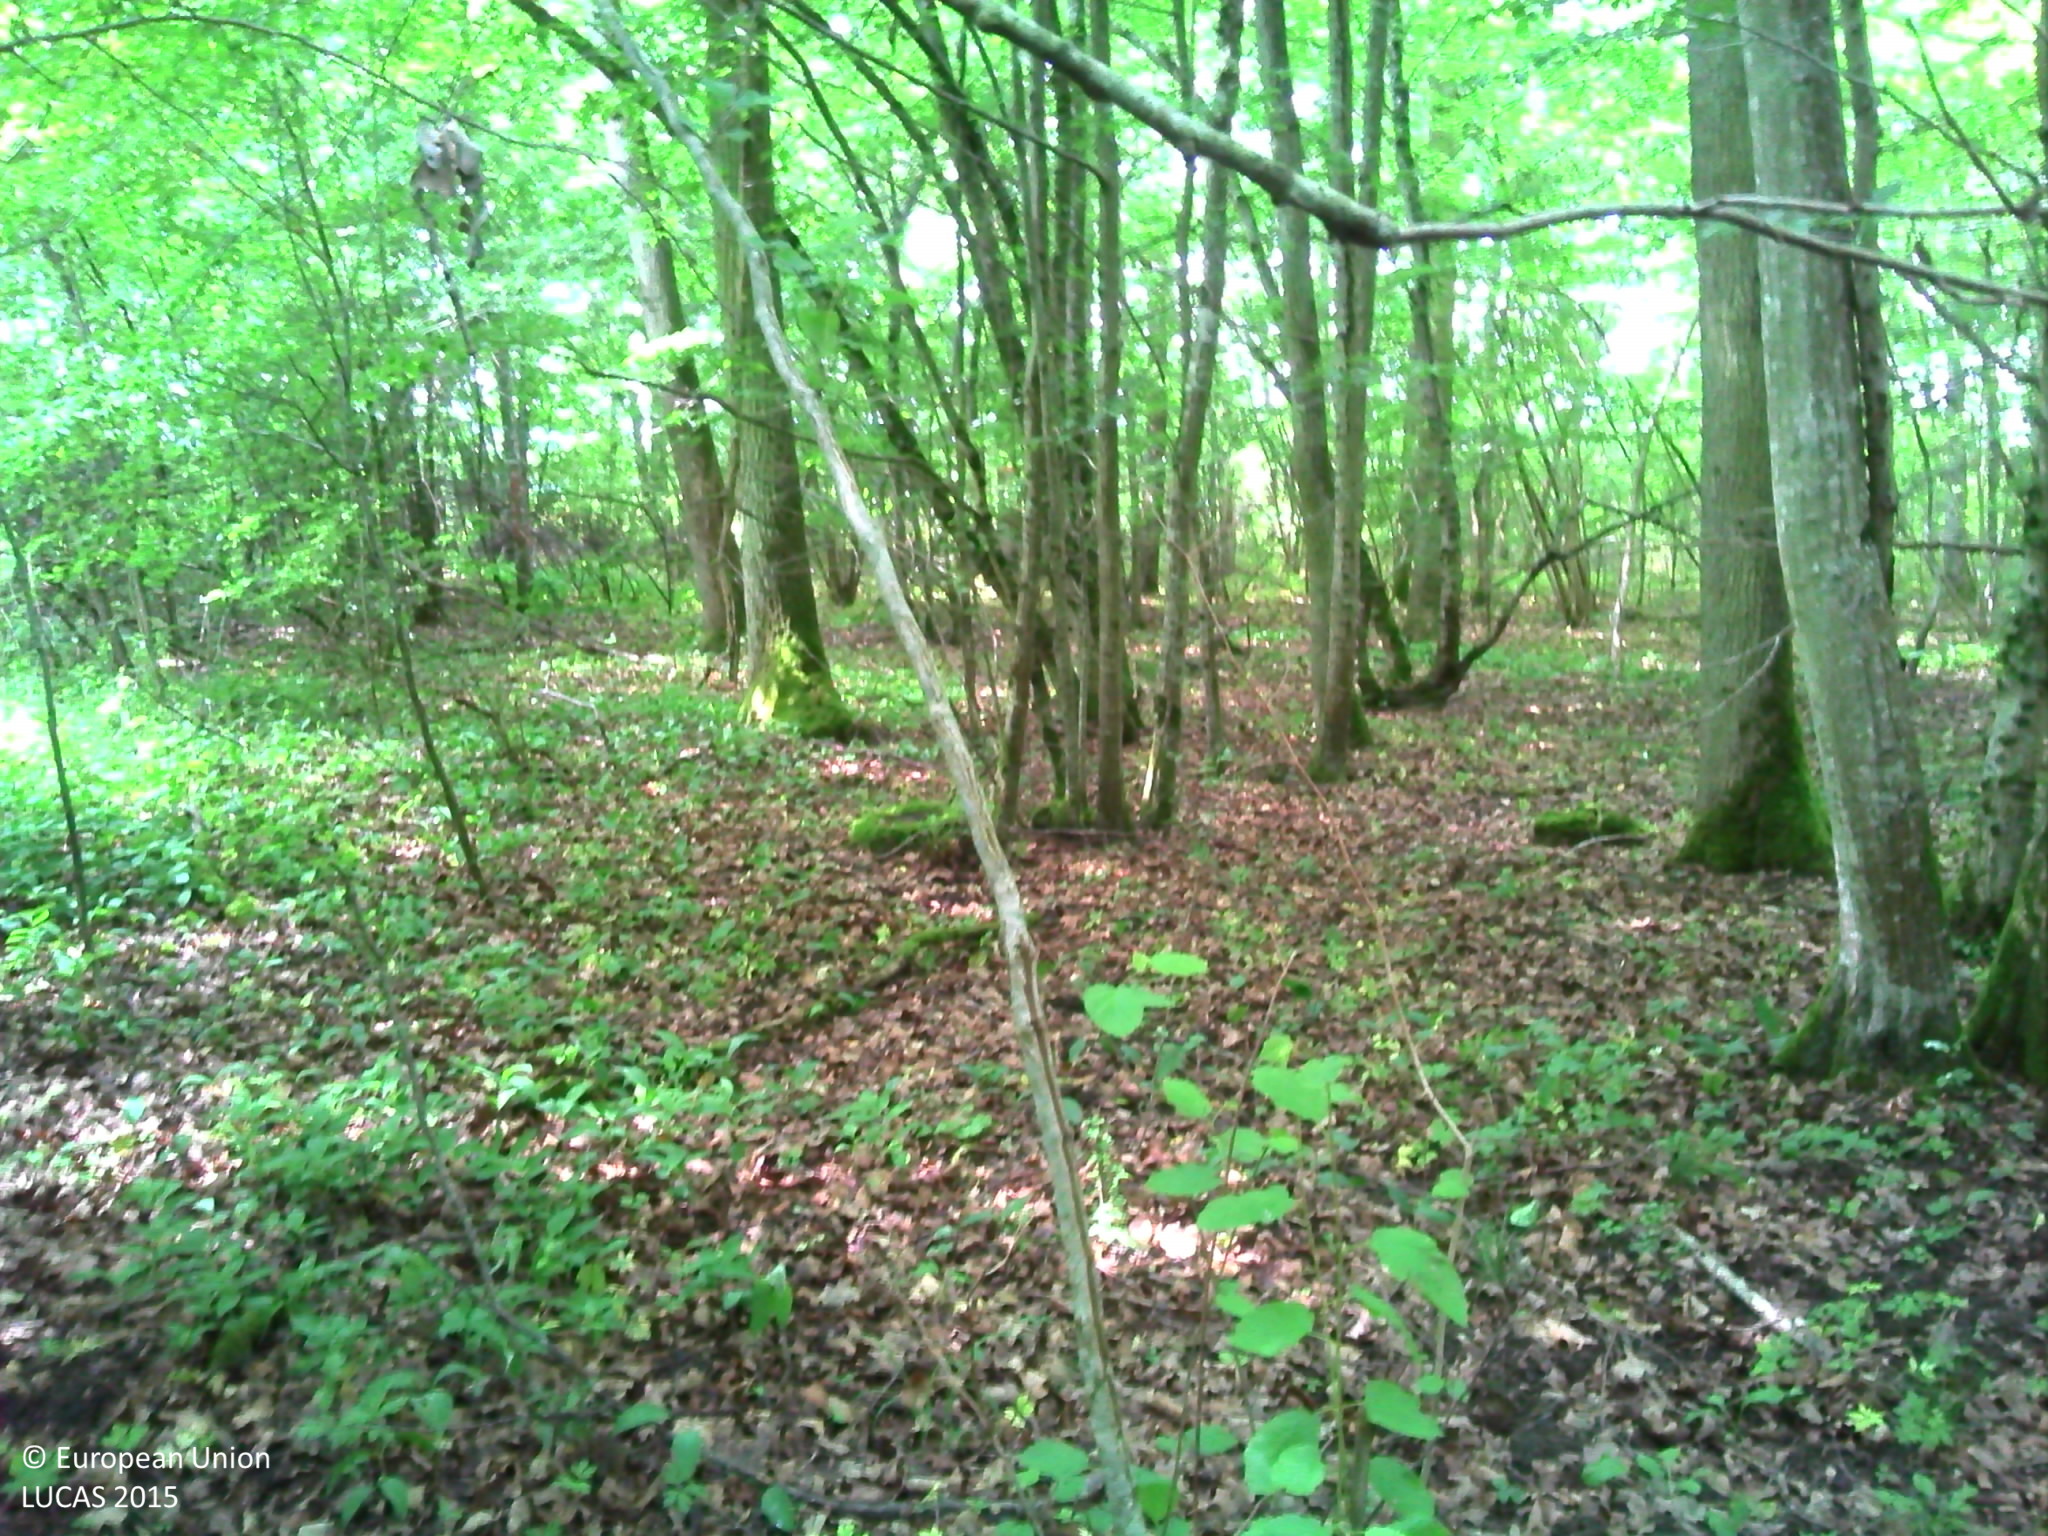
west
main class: Woodland
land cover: Broadleaved woodland
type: mesophytic deciduous forest
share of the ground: > 75 %
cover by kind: broadleaved forest trees 90 %, lichens and mosses 10 %
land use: Forestry
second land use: Amenities, museums, leisure
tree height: > 5 m
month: June
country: FR
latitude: 48.7251
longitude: 5.9351
